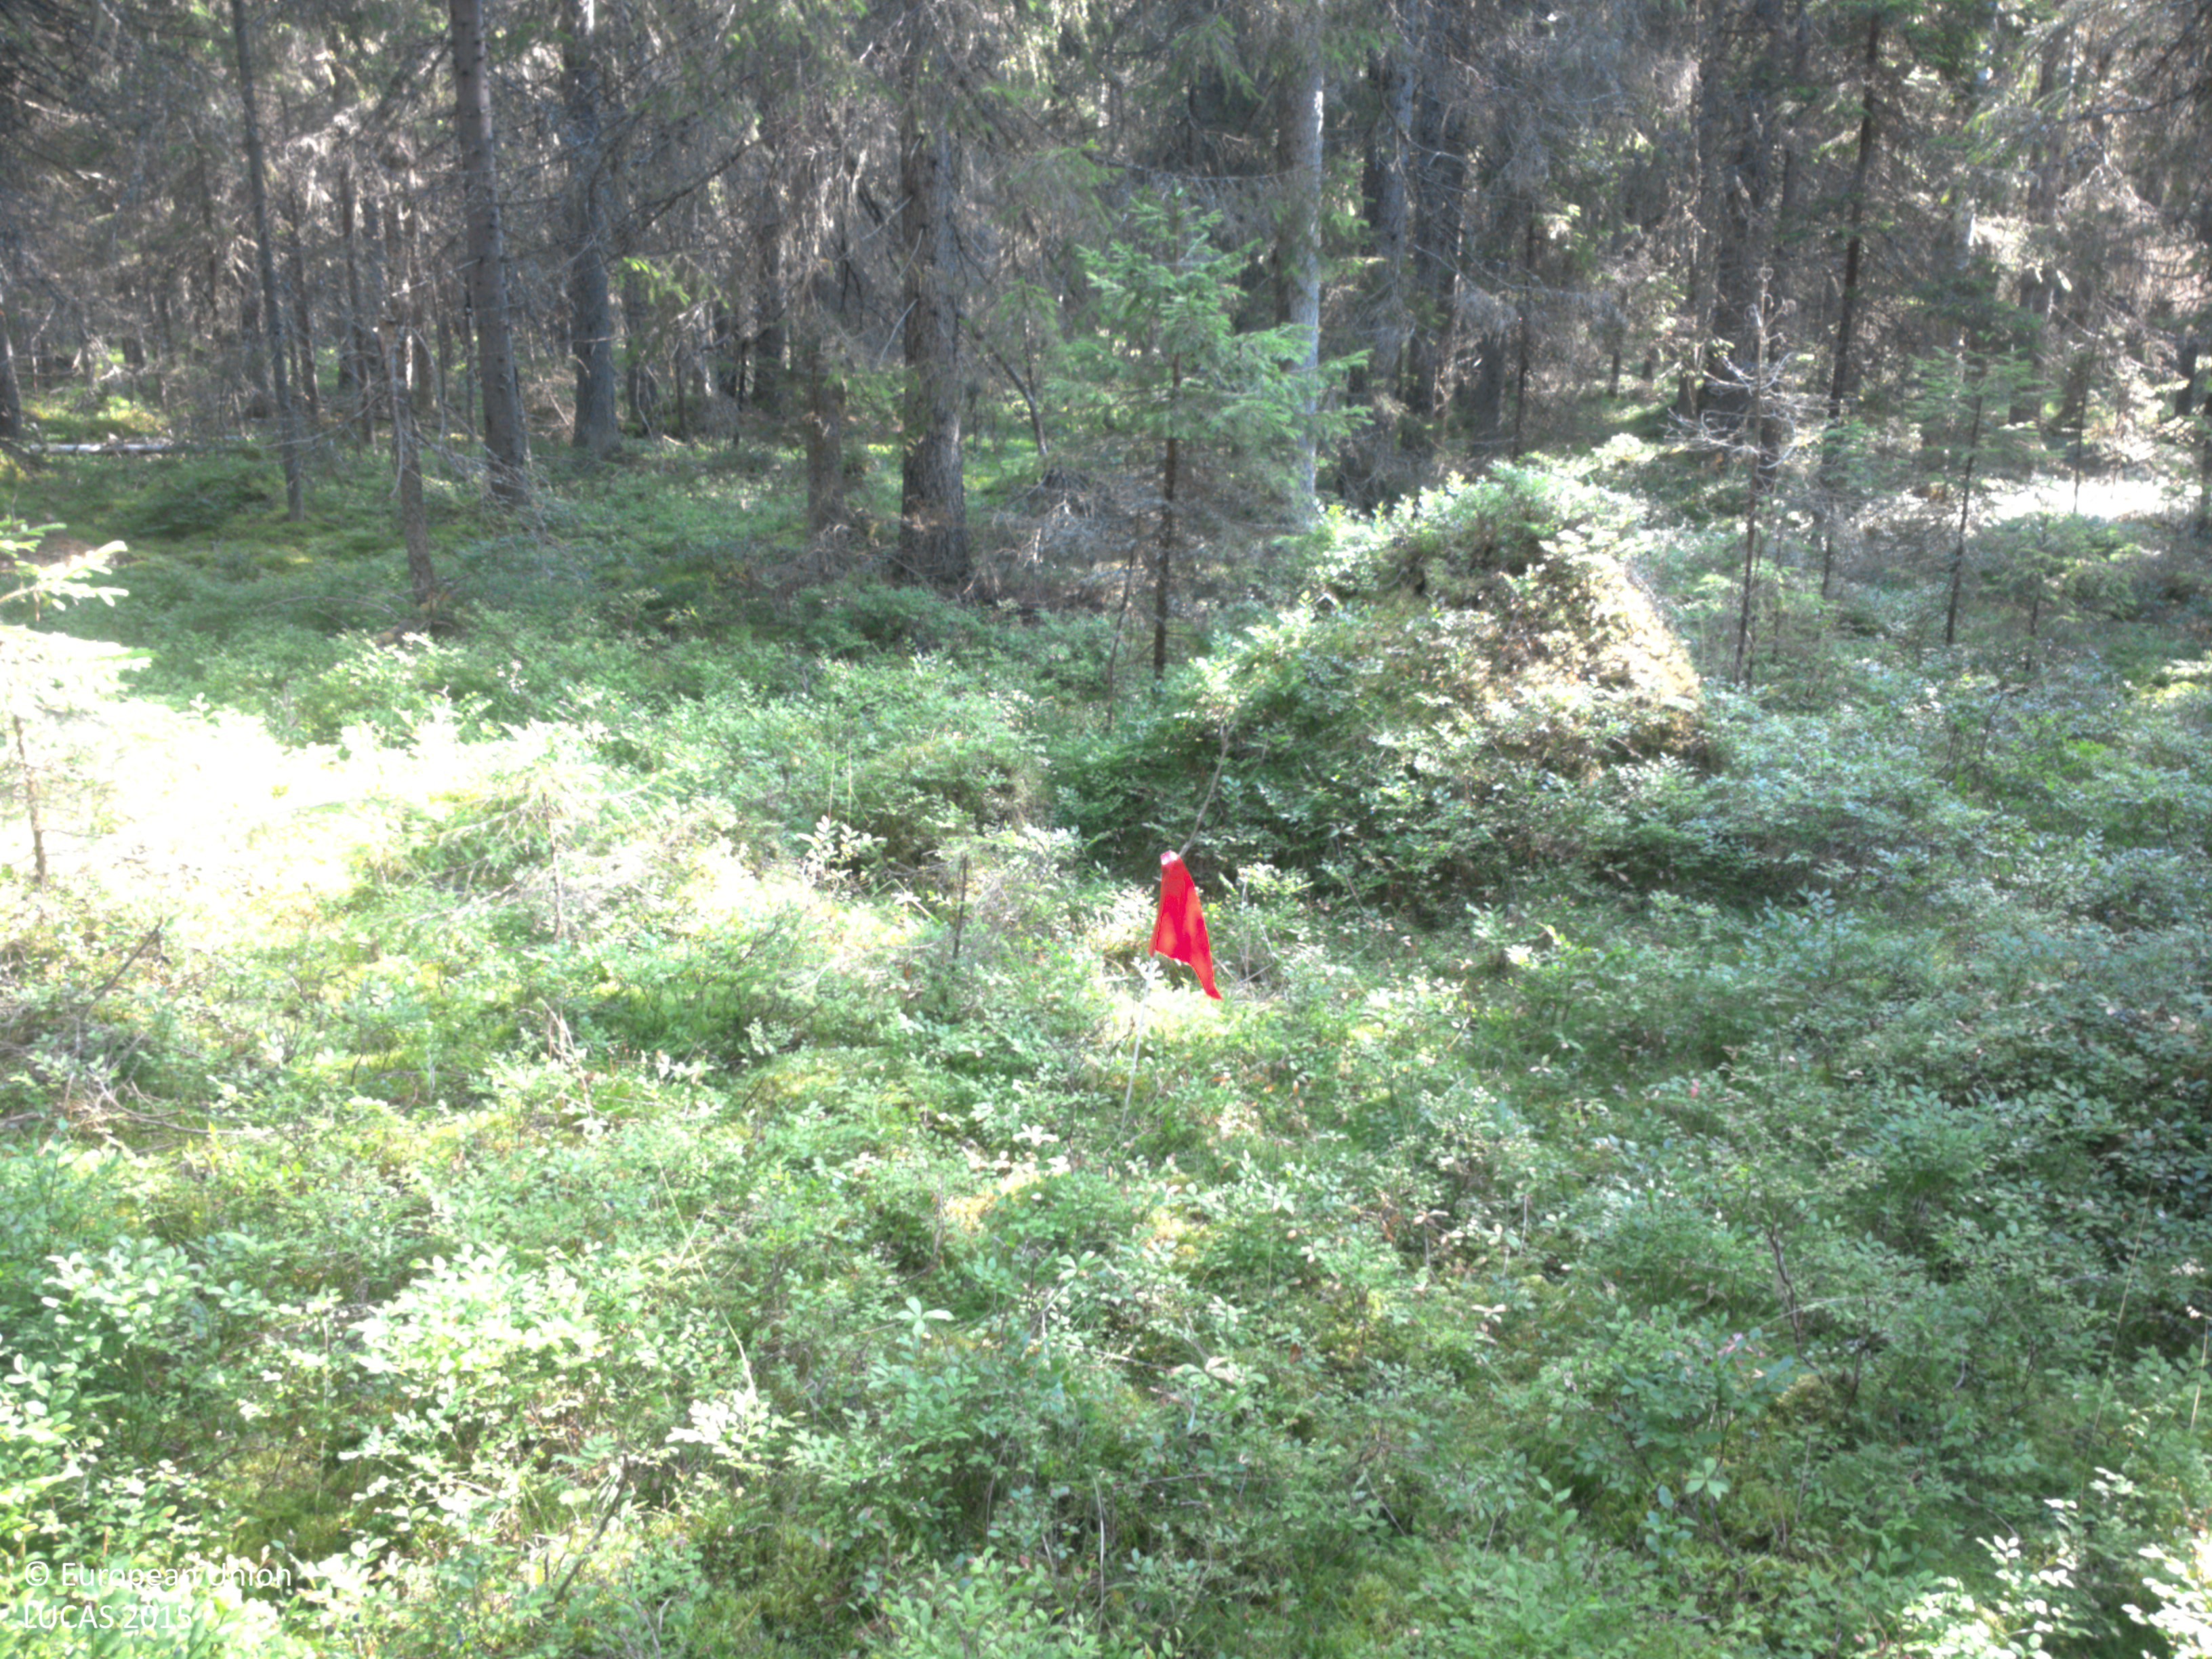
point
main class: Woodland
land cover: Spruce dominated coniferous woodland
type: boreal forest
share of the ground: 50 - 75 %
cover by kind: coniferous forest trees 60 %, shrubs 40 %
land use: Forestry
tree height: > 5 m
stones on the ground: < 10 %
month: August
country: SE
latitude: 63.5057
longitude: 19.6046
